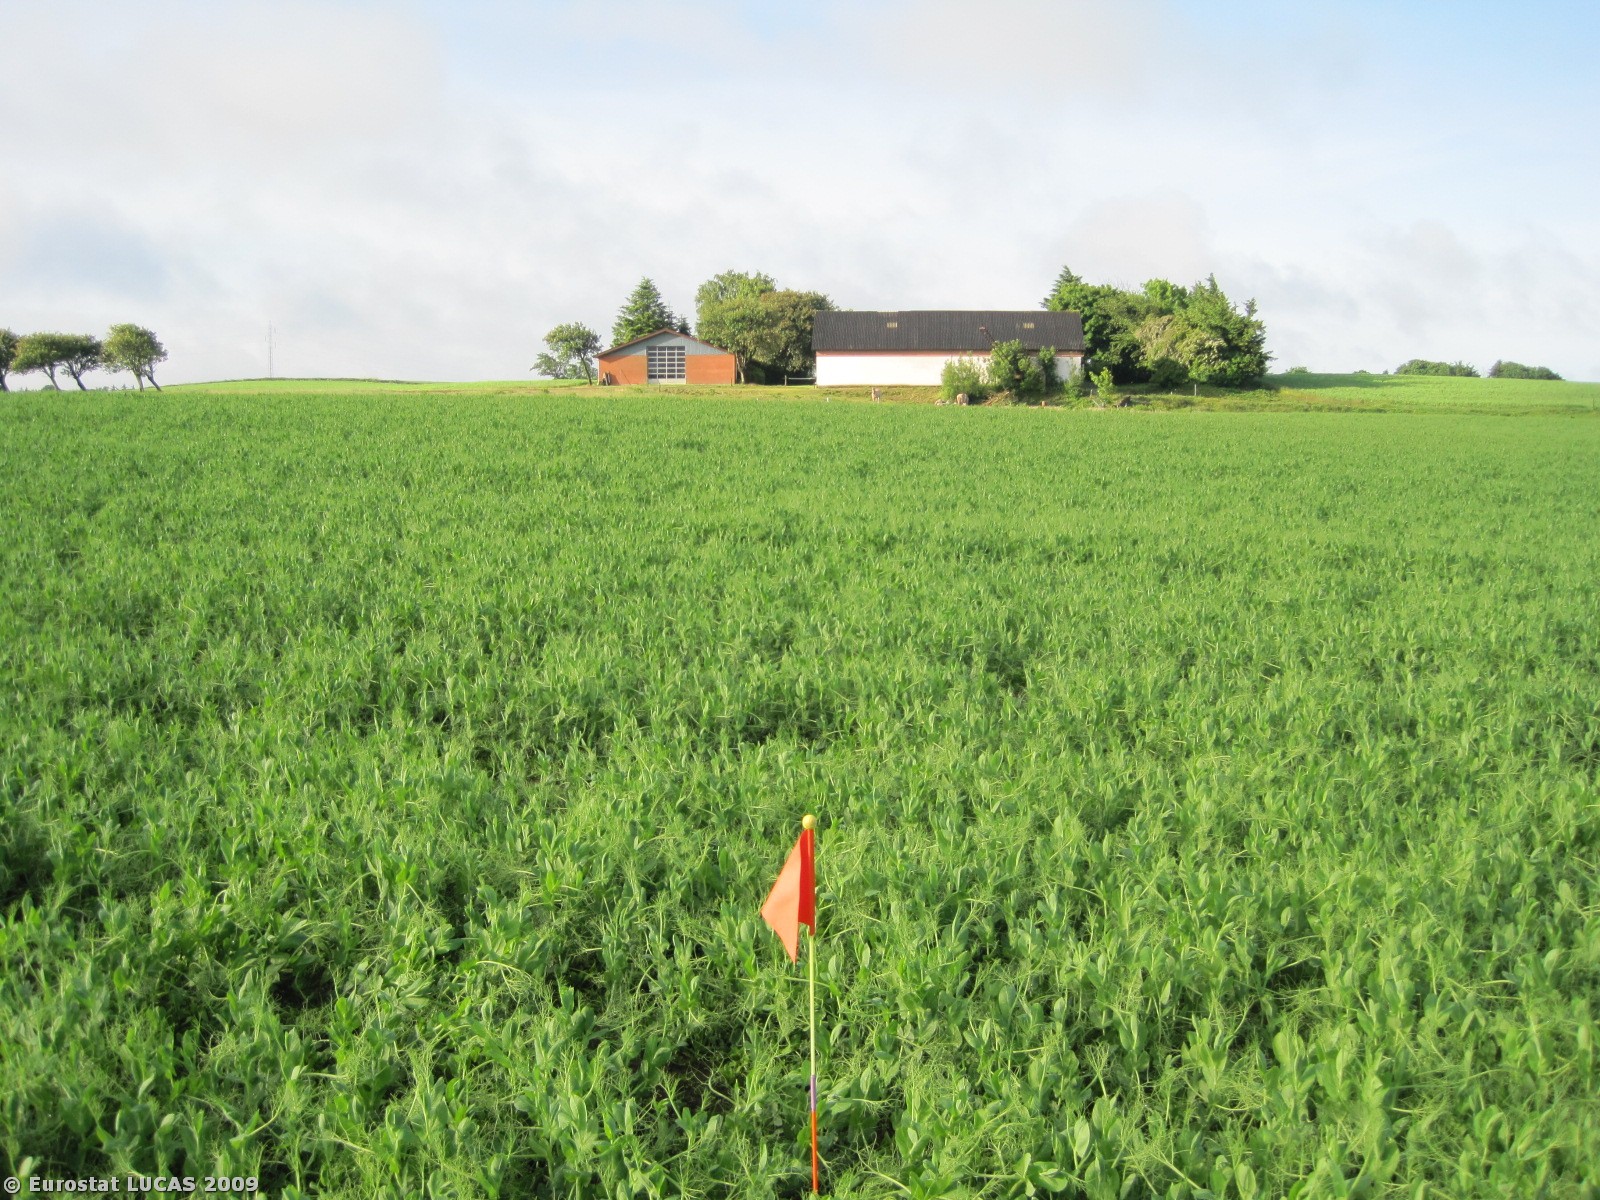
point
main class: Cropland
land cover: Dry pulses
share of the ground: 50 - 75 %
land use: Agriculture (excluding fallow land and kitchen gardens)
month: June
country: DK
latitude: 57.3382
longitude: 10.1493
